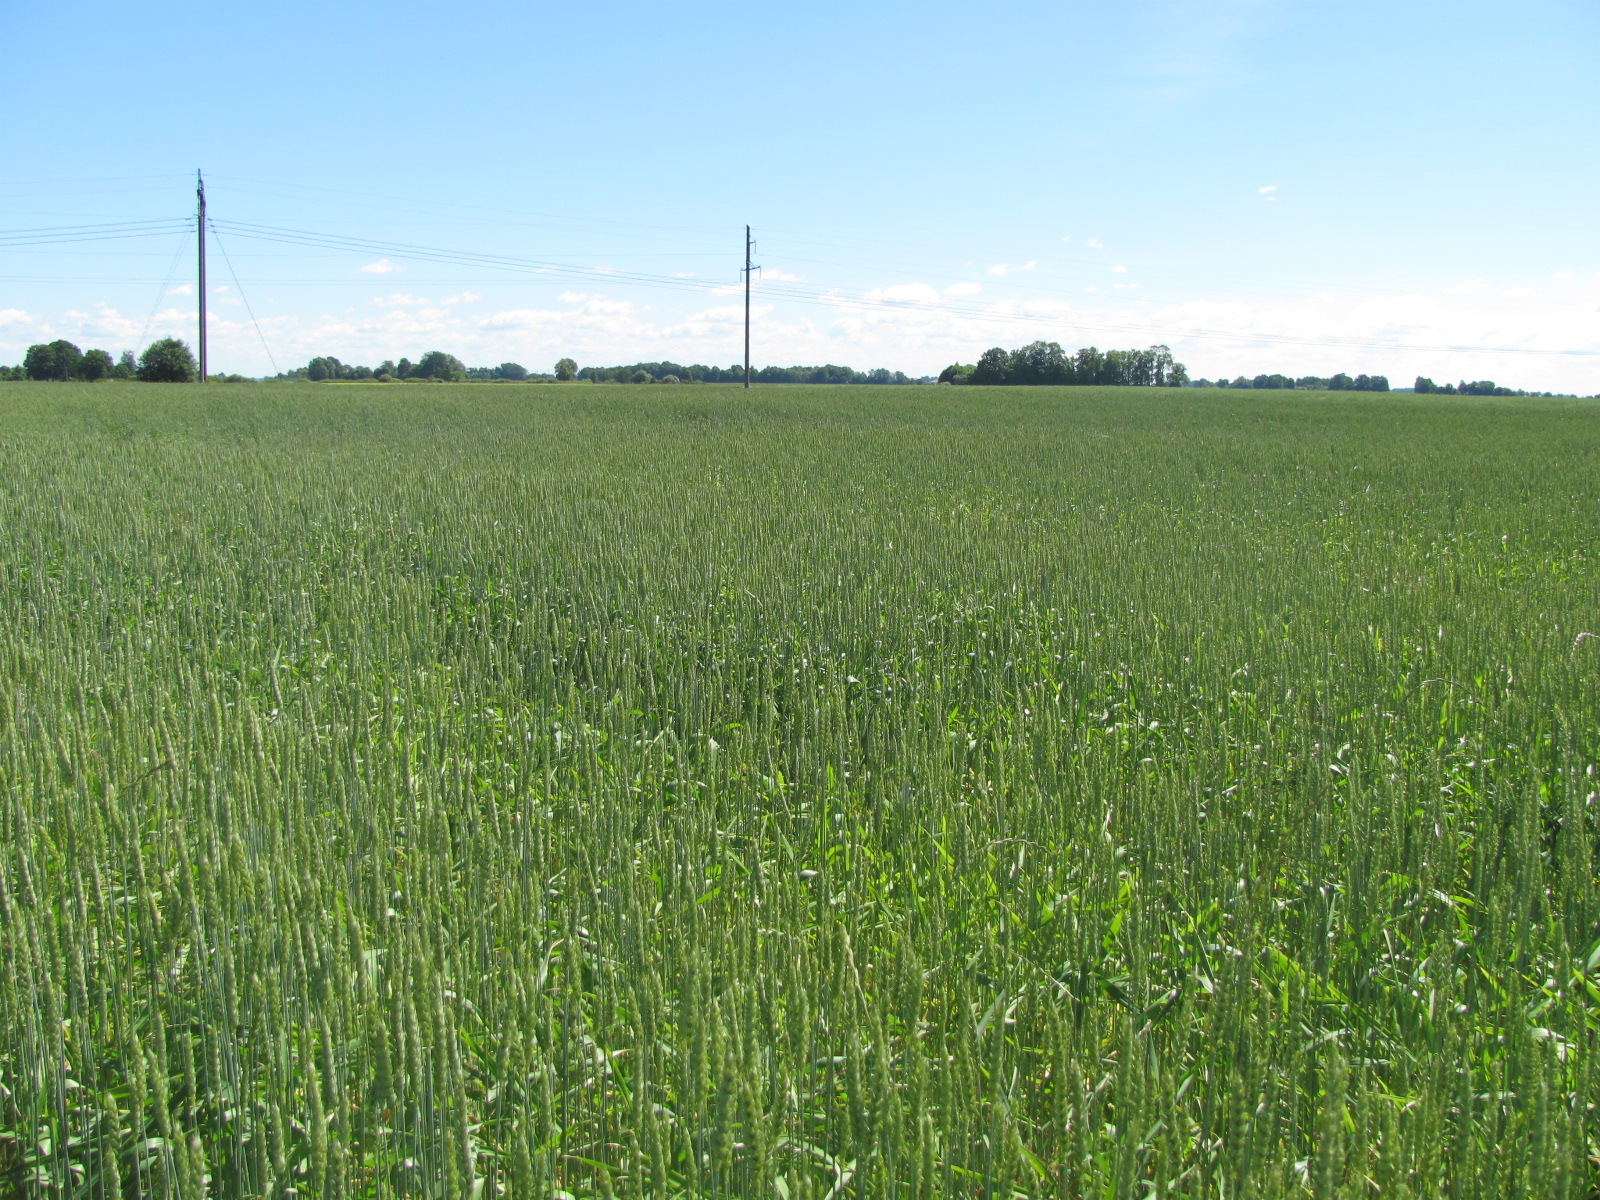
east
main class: Cropland
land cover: Common wheat
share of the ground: > 75 %
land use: Agriculture (excluding fallow land and kitchen gardens)
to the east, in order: Common wheat; Grass margins; Common wheat; Electric lines; Common wheat; Electric lines; Common wheat
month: July
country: LV
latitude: 56.5419
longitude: 23.7242
